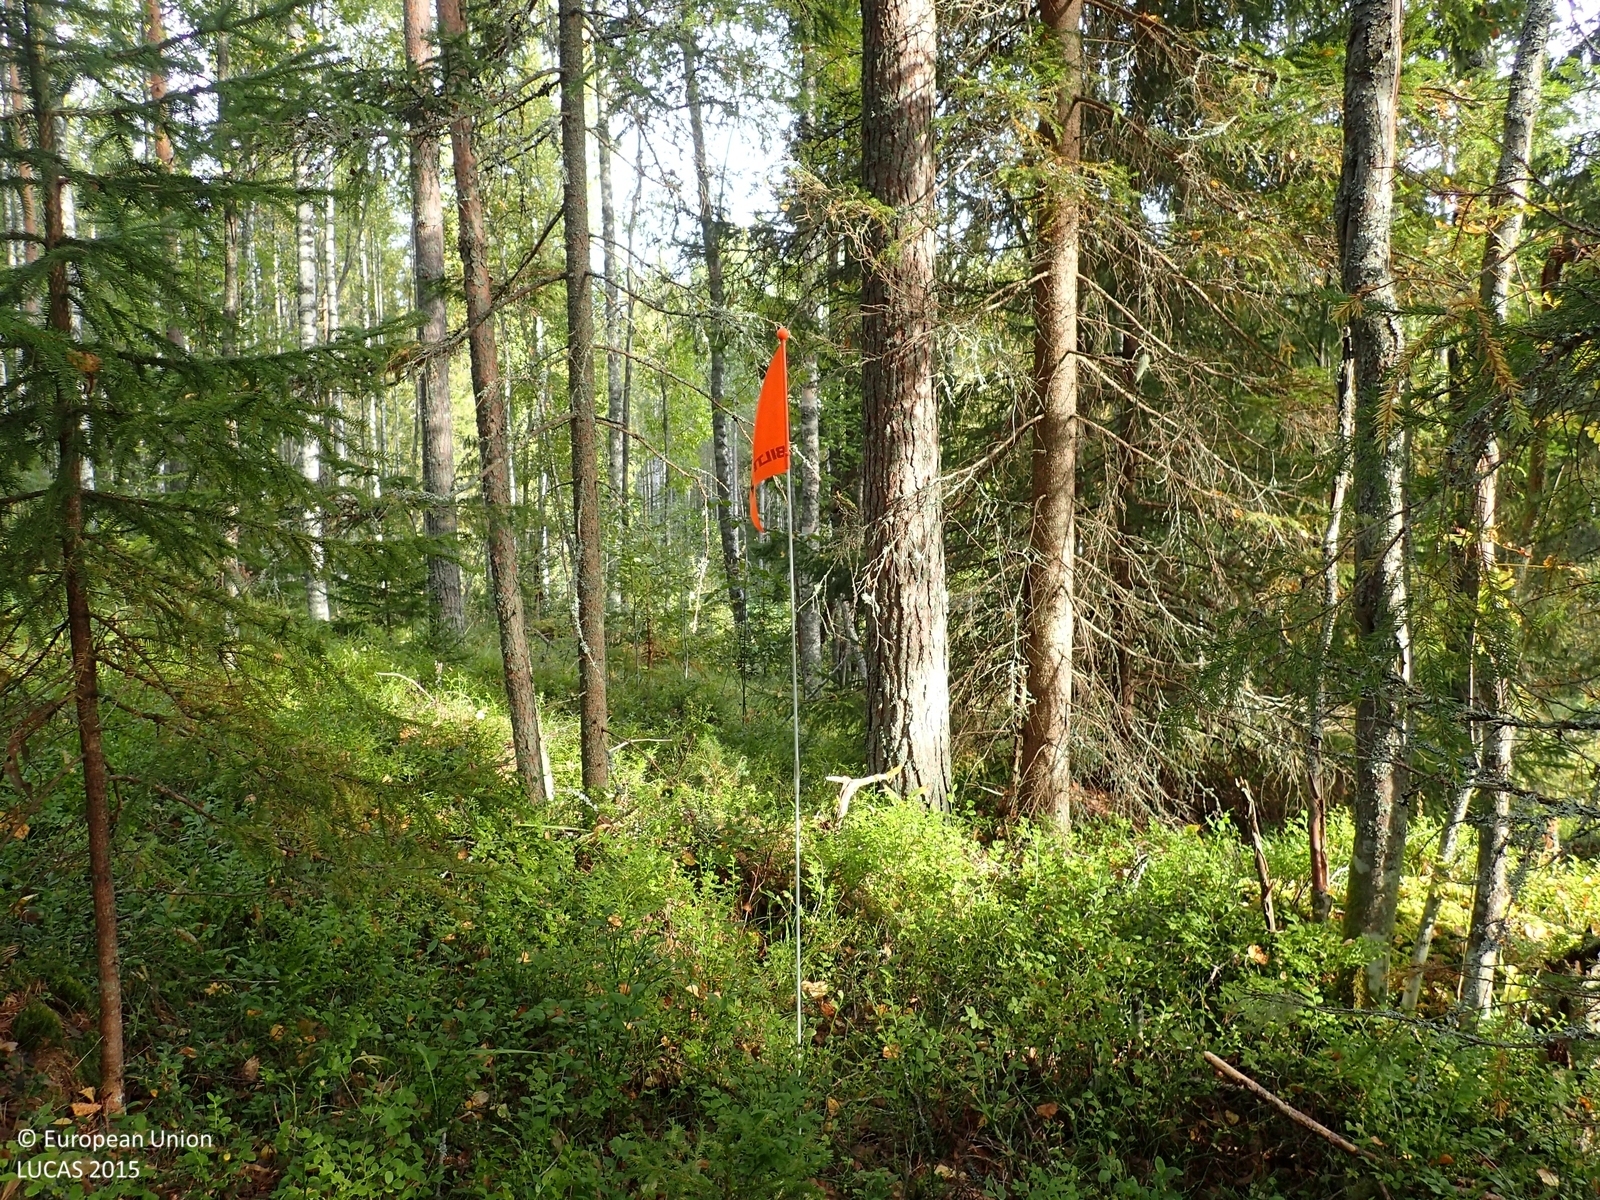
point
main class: Woodland
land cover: Pine dominated mixed woodland
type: boreal forest
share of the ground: > 75 %
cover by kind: coniferous forest trees 55 %, broadleaved forest trees 20 %, shrubs 20 %, herbaceous plants 5 %
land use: Forestry
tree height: > 5 m
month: September
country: FI
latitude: 63.0001
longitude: 26.2157
